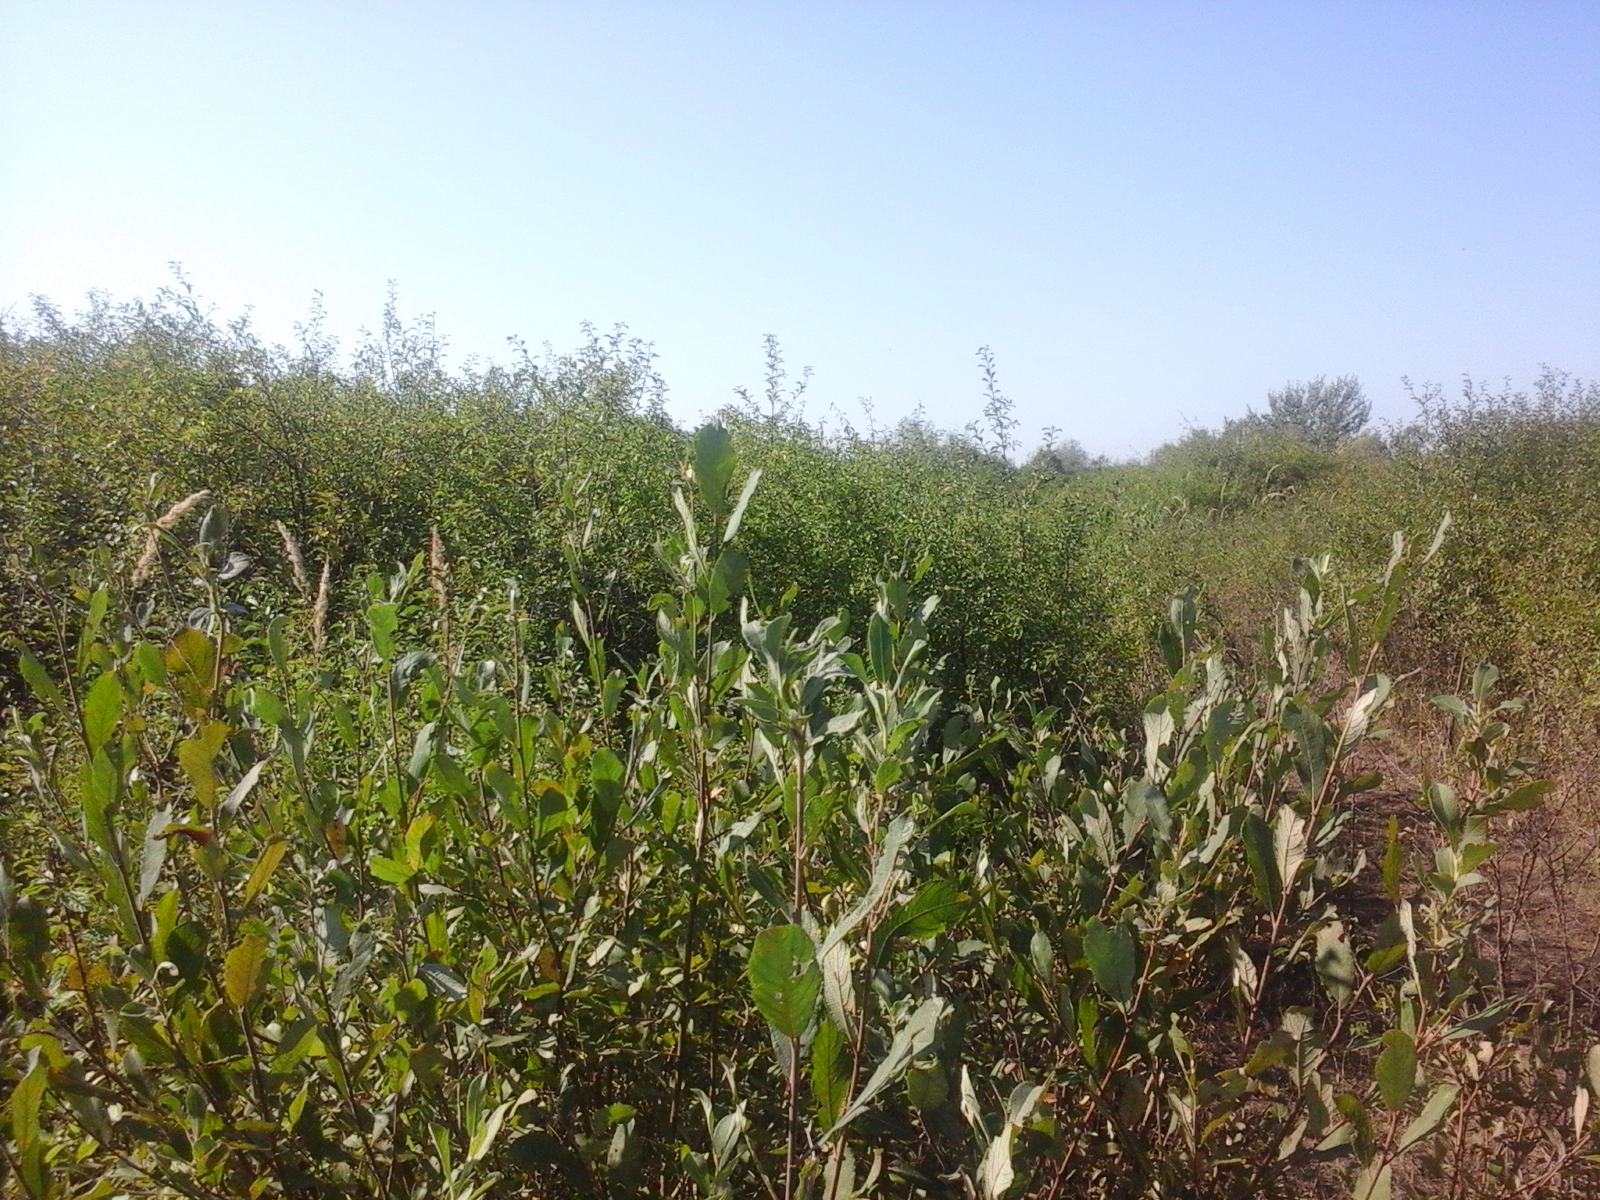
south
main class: Shrubland
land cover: Shrubland with sparse tree cover
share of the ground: > 75 %
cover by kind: shrubs 95 %, broadleaved forest trees 5 %
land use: Semi-natural and natural areas not in use
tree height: < 5 m
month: August
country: RO
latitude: 45.6876
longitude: 21.7078
